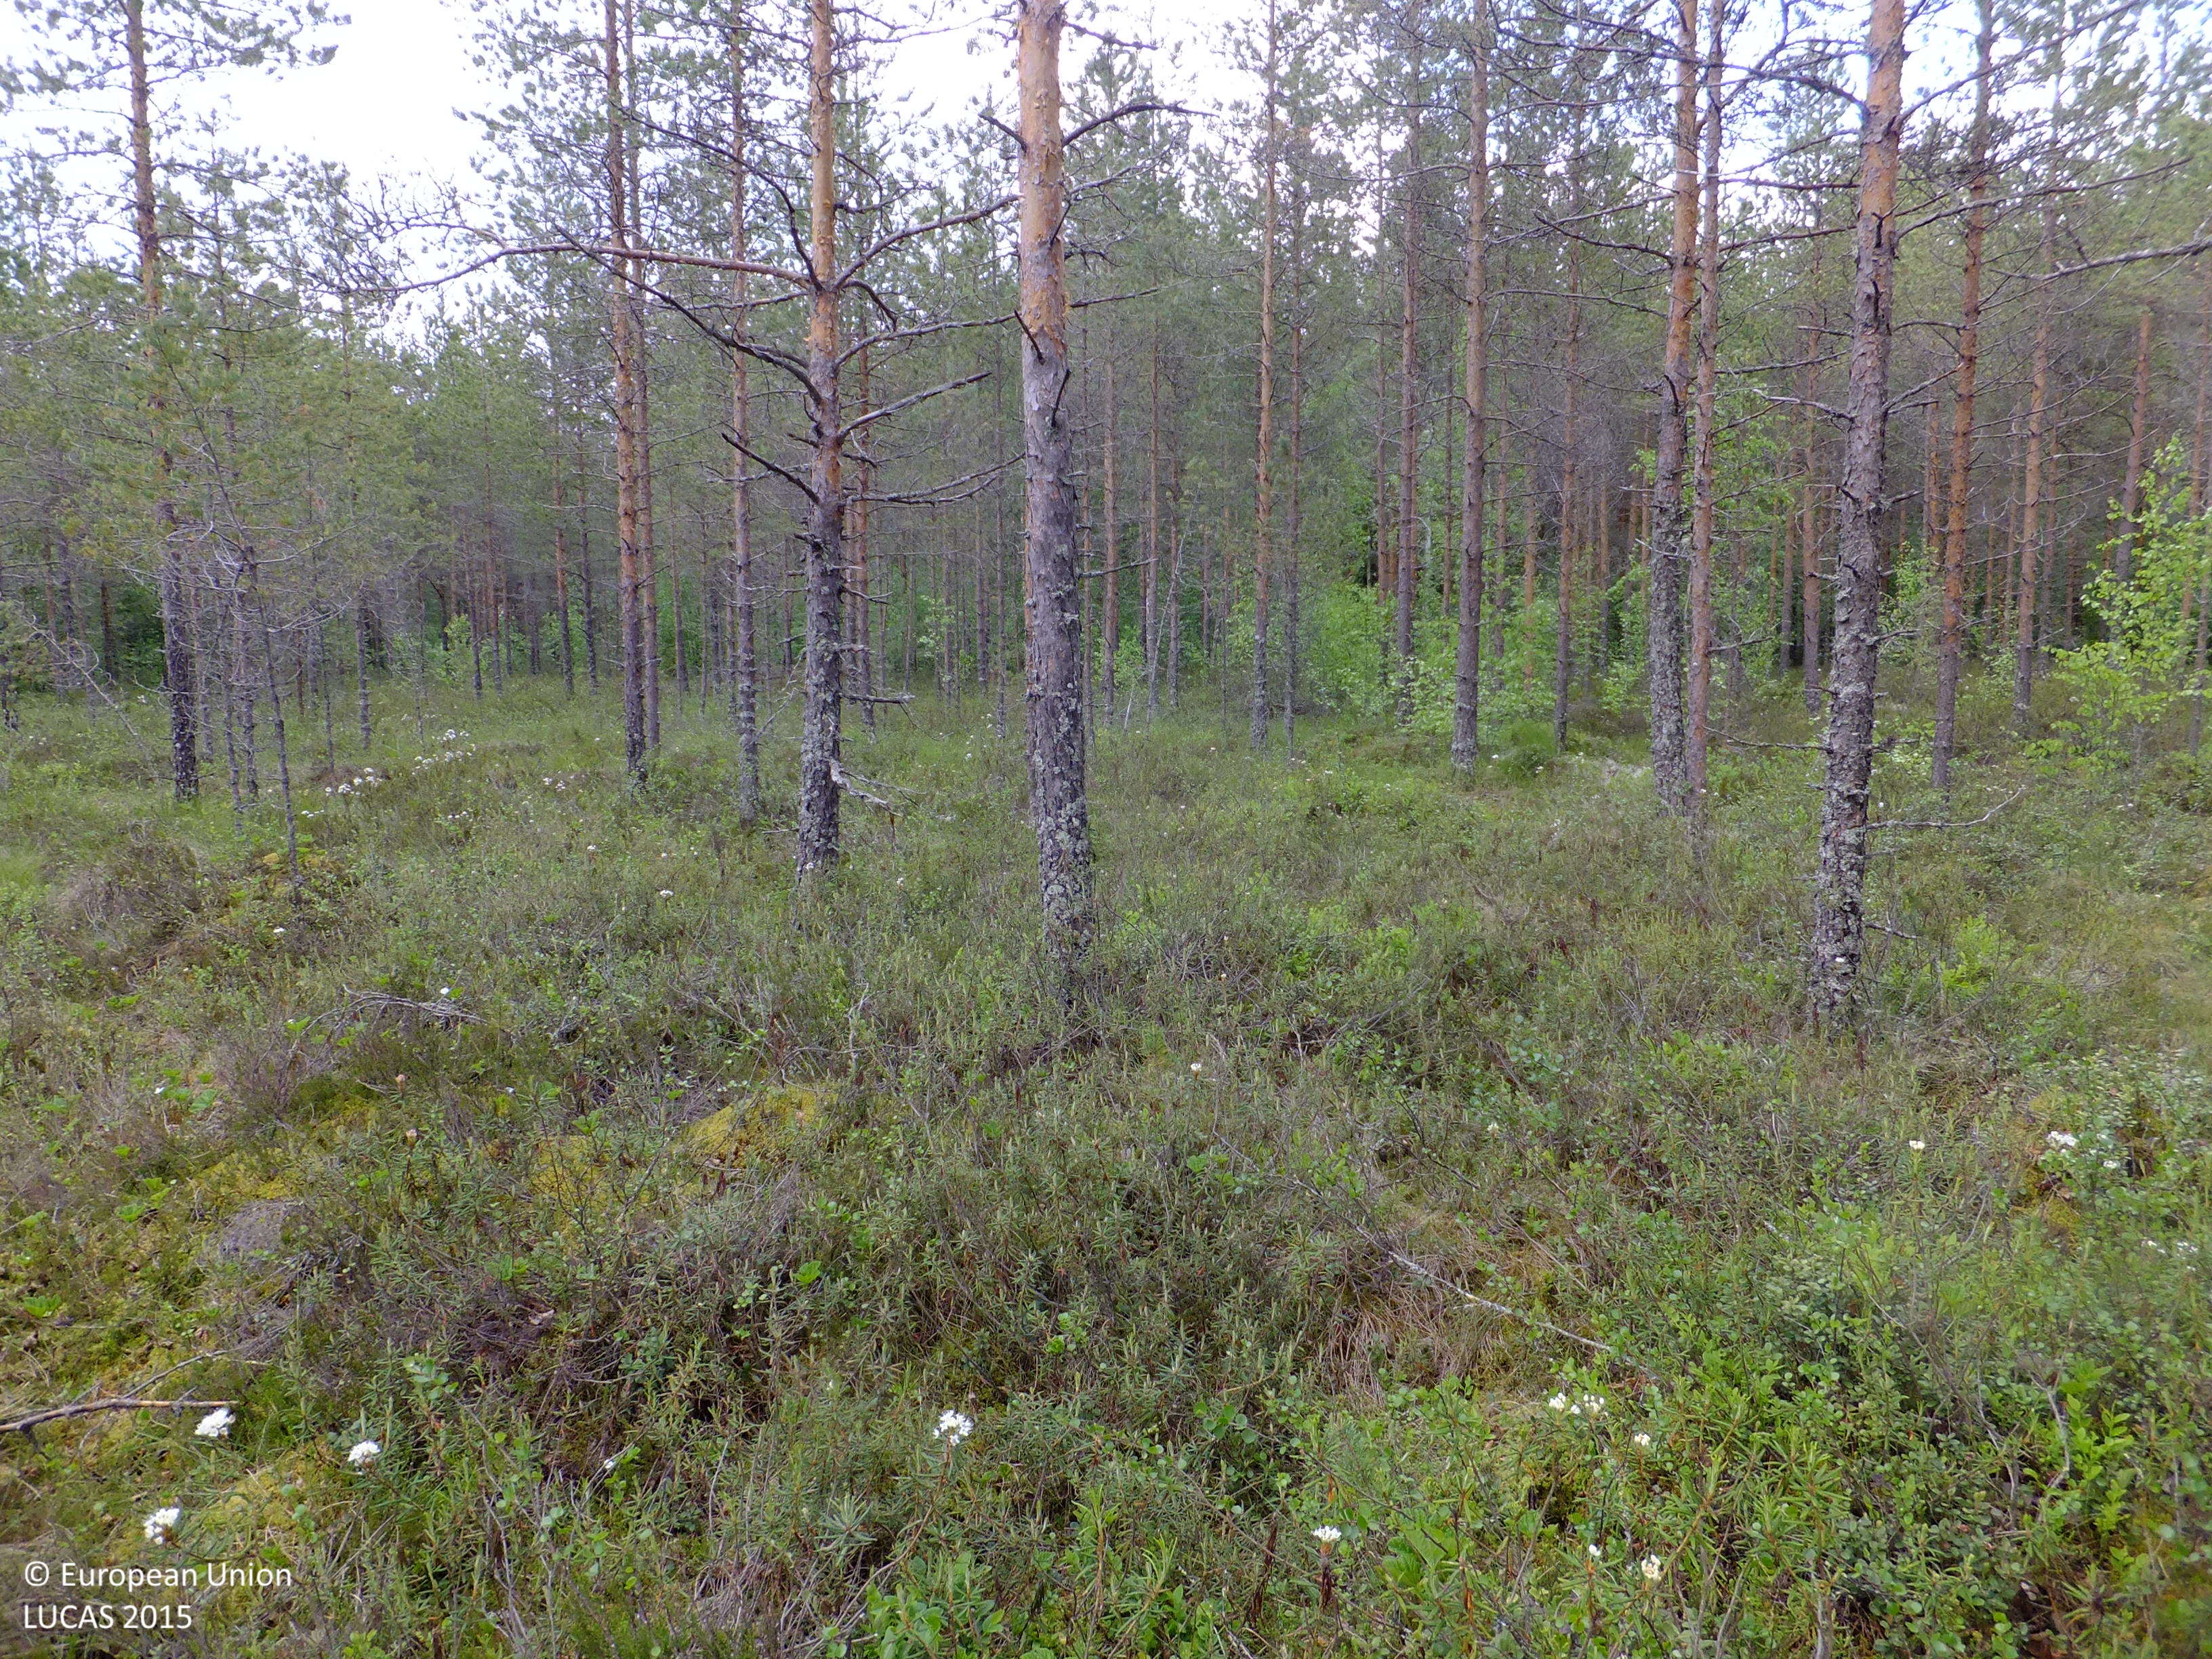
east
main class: Woodland
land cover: Pine dominated coniferous woodland
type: mire and swamp forests
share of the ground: 50 - 75 %
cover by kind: coniferous forest trees 60 %, shrubs 25 %, lichens and mosses 10 %, broadleaved forest trees 5 %
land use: Forestry
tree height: > 5 m
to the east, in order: Pine dominated coniferous woodland; Ditches and canals; Pine dominated coniferous woodland; Ditches and canals; Other coniferous woodland; Ditches and canals; Other coniferous woodland
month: June
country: FI
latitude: 63.6028
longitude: 25.0285
